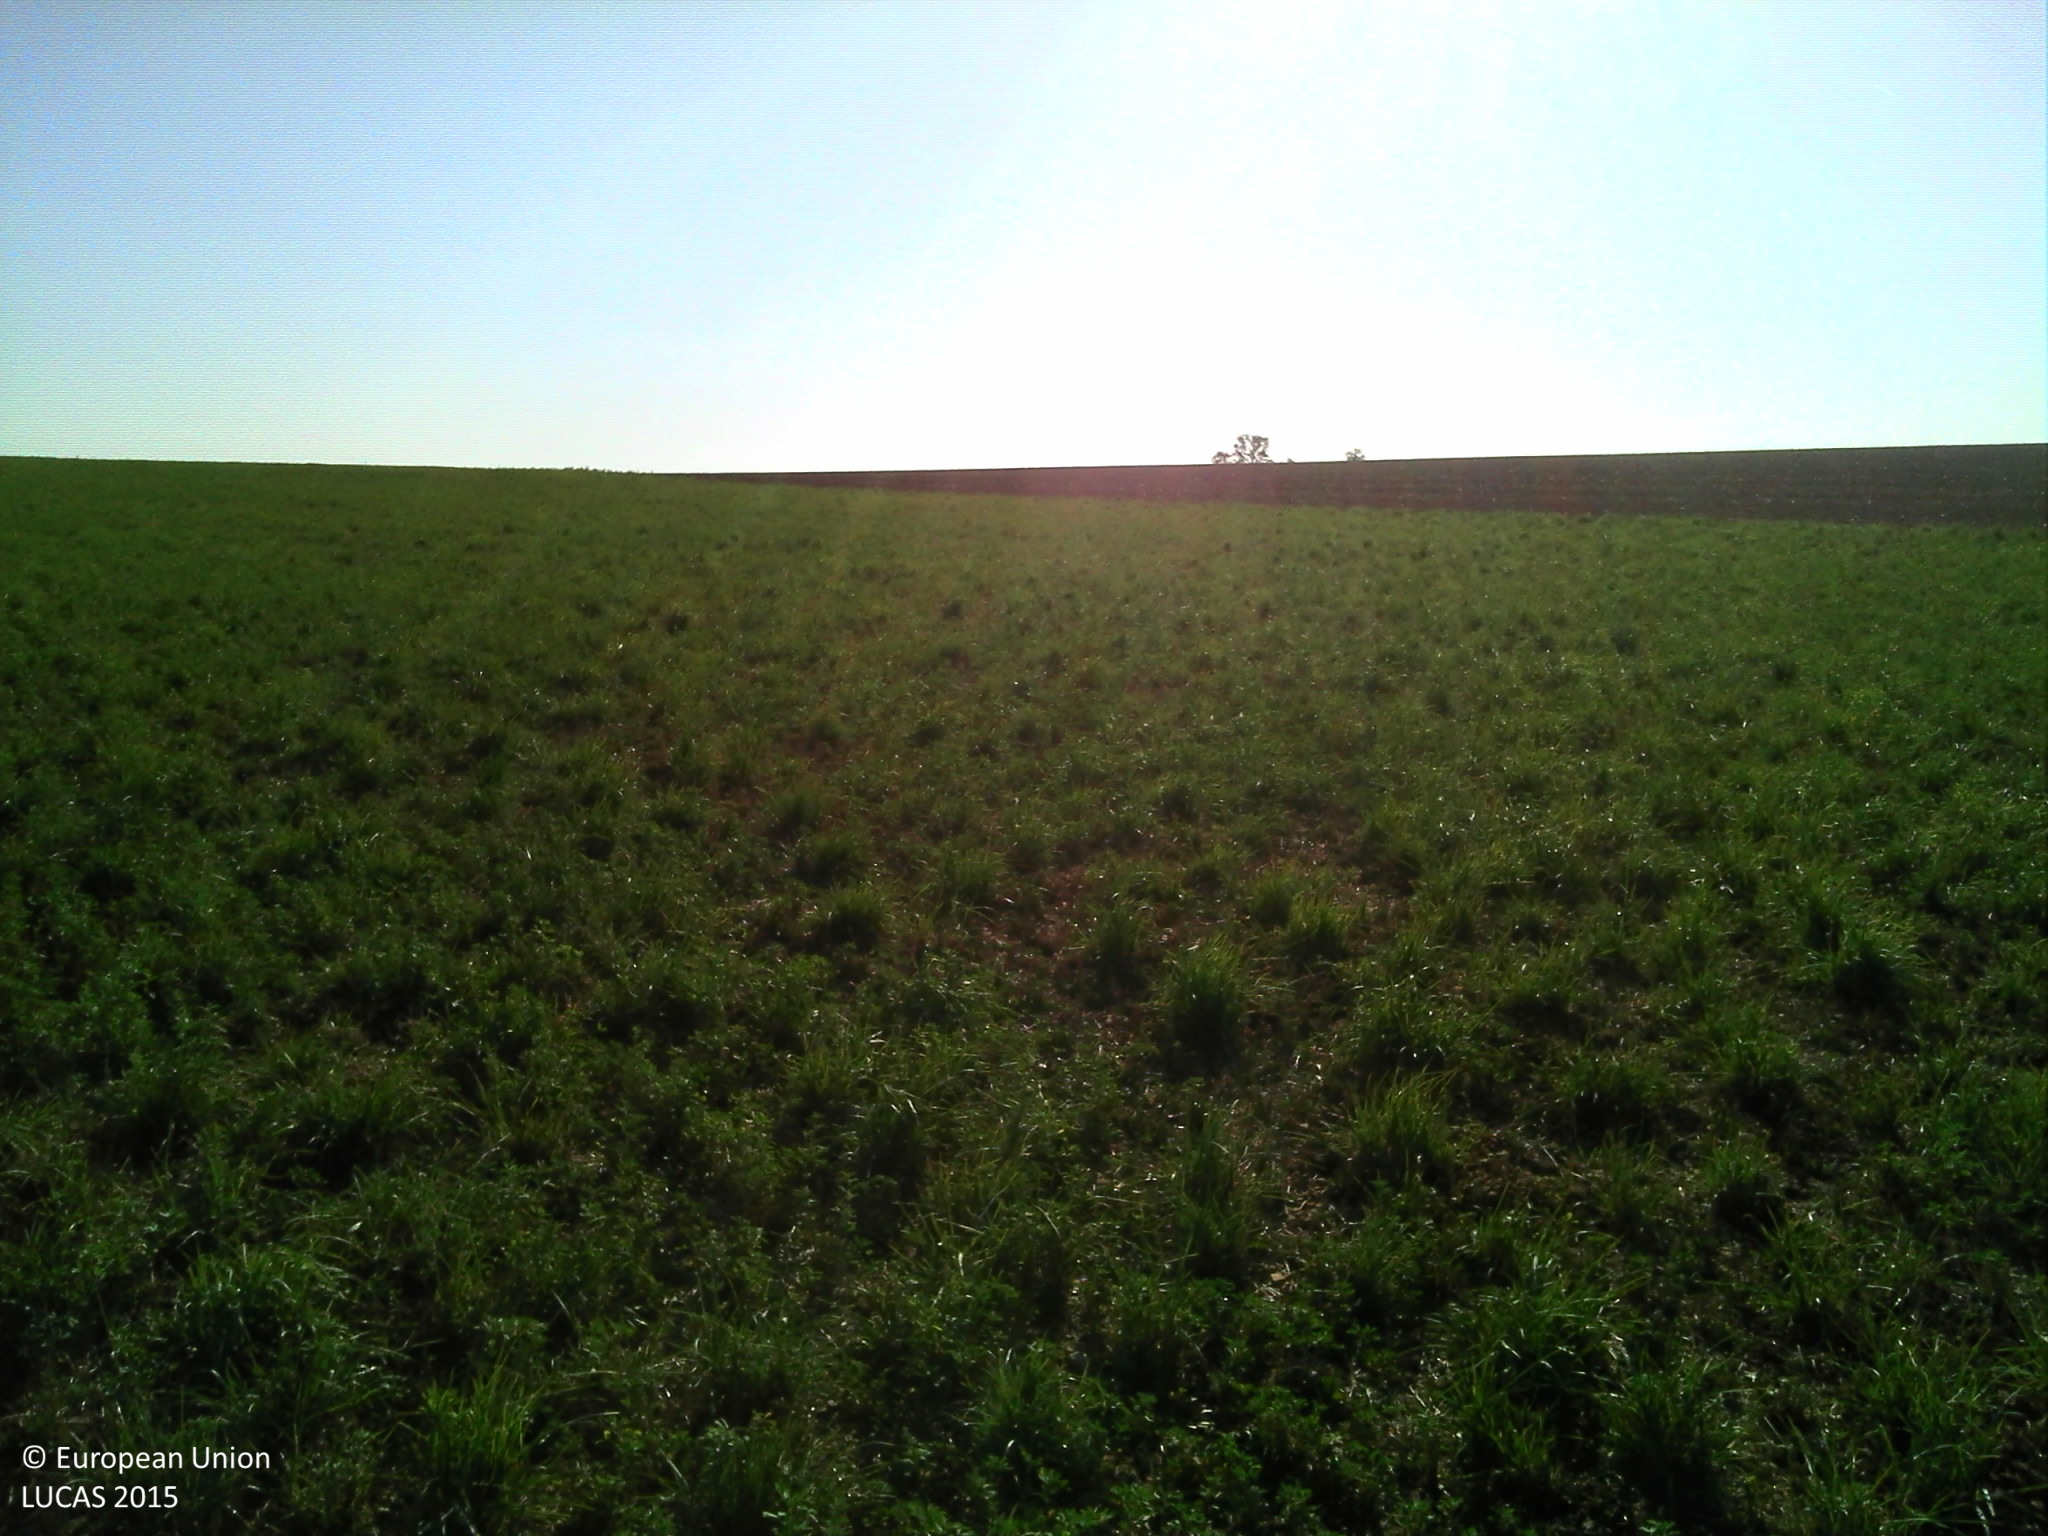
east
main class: Cropland
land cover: Lucerne
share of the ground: > 75 %
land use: Agriculture (excluding fallow land and kitchen gardens)
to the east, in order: Lucerne; Rape and turnip rape
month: September
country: FR
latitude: 47.5895
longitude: 4.6669
